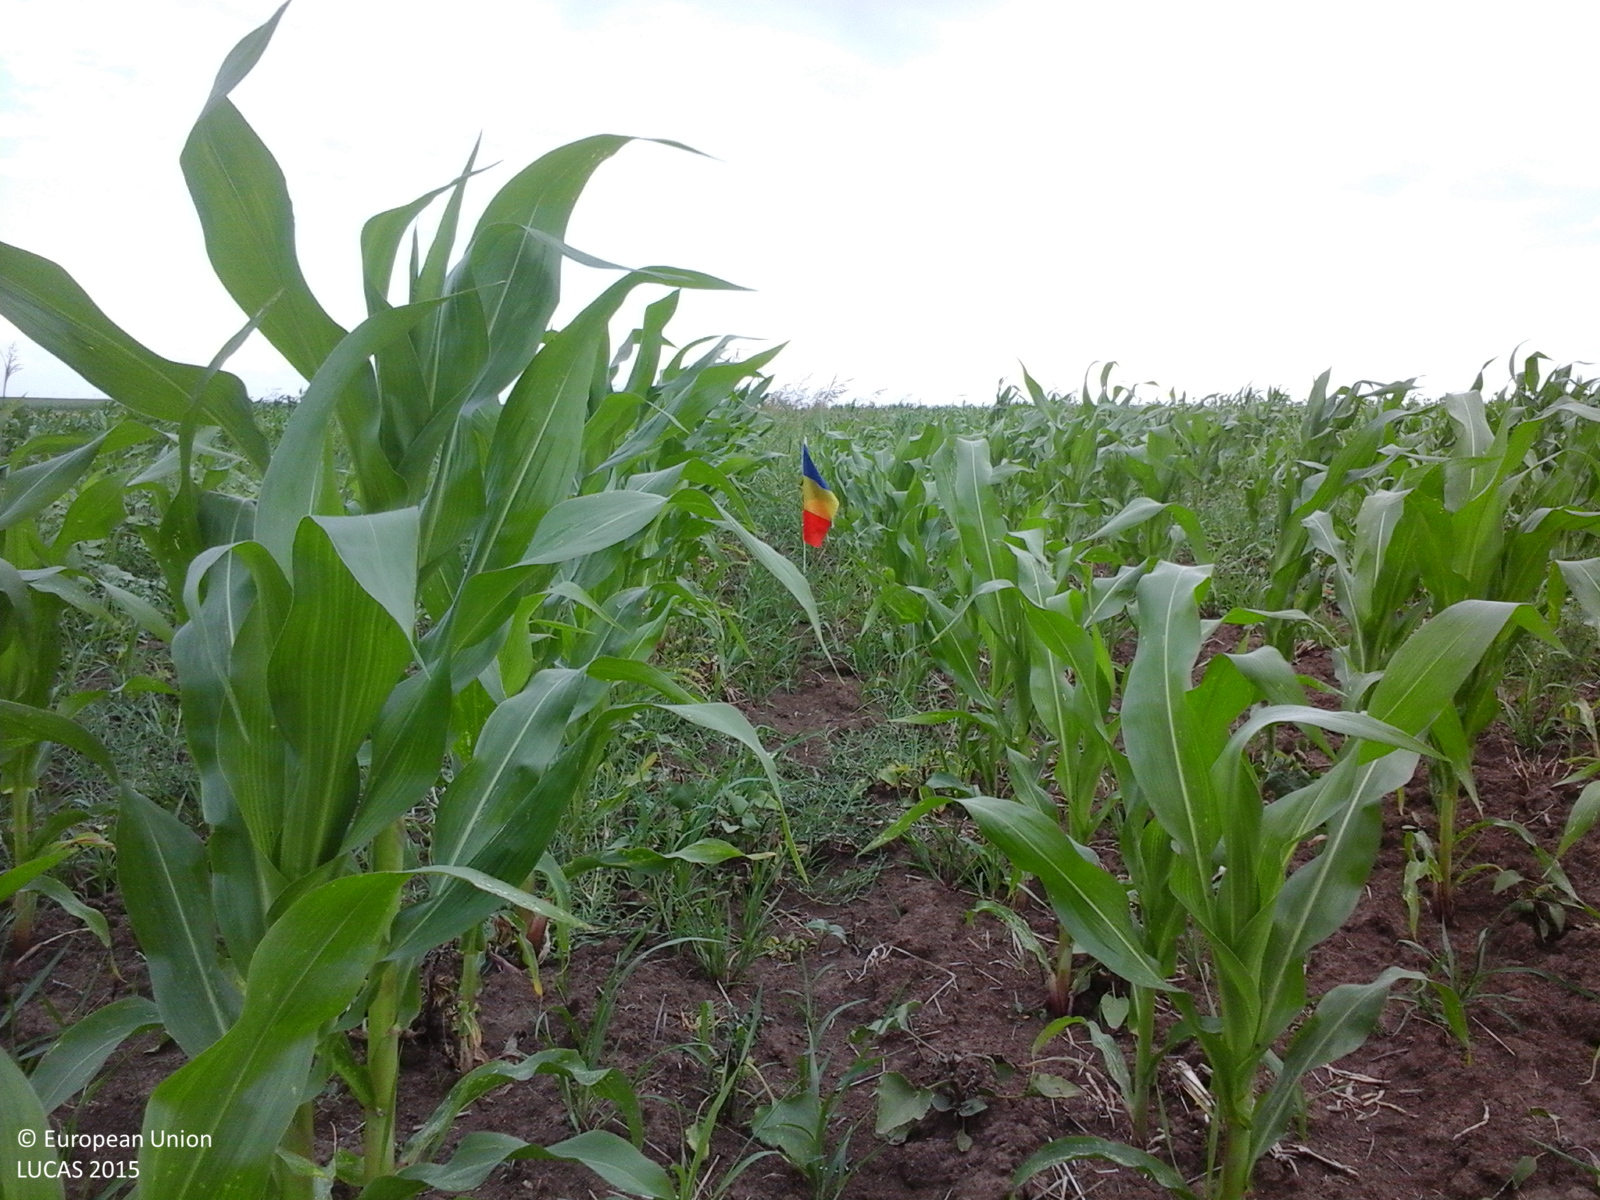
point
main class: Cropland
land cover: Maize
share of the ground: 50 - 75 %
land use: Agriculture (excluding fallow land and kitchen gardens)
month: July
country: RO
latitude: 44.2767
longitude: 25.3853
